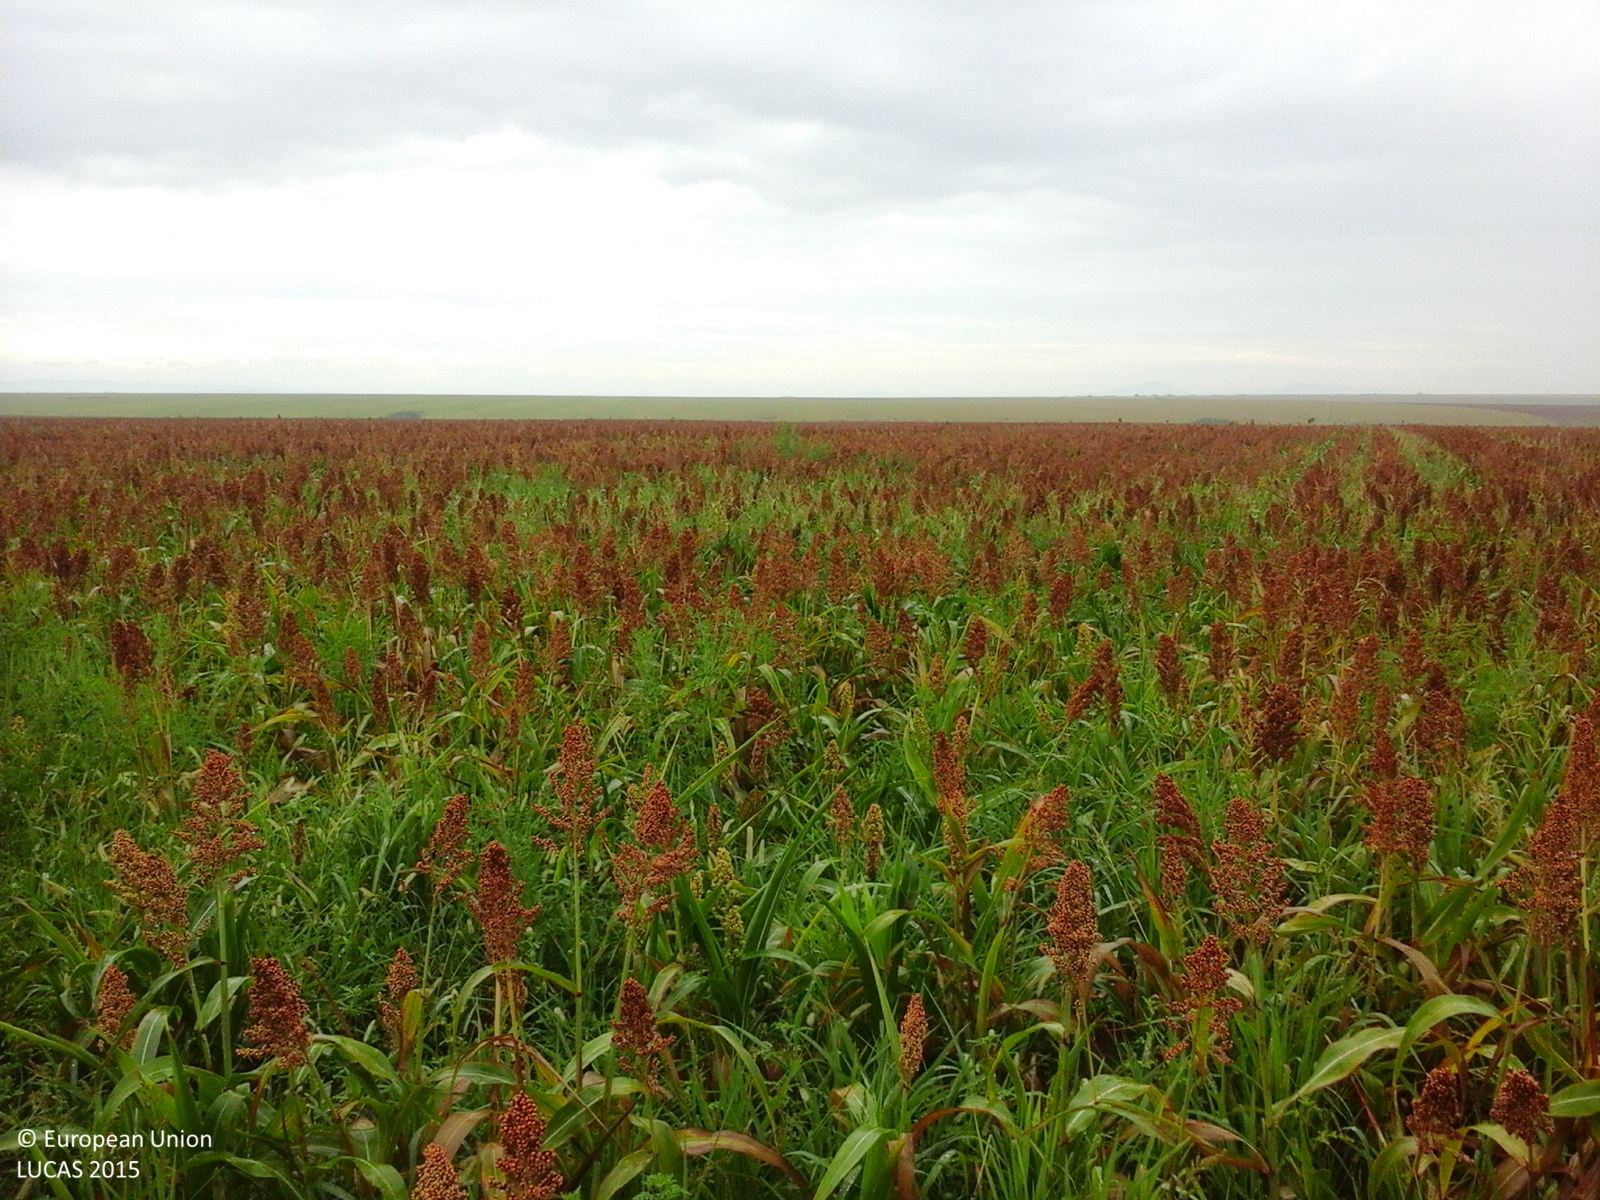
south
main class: Cropland
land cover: Other cereals
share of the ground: > 75 %
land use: Agriculture (excluding fallow land and kitchen gardens)
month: August
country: RO
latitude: 45.4762
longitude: 21.4810
